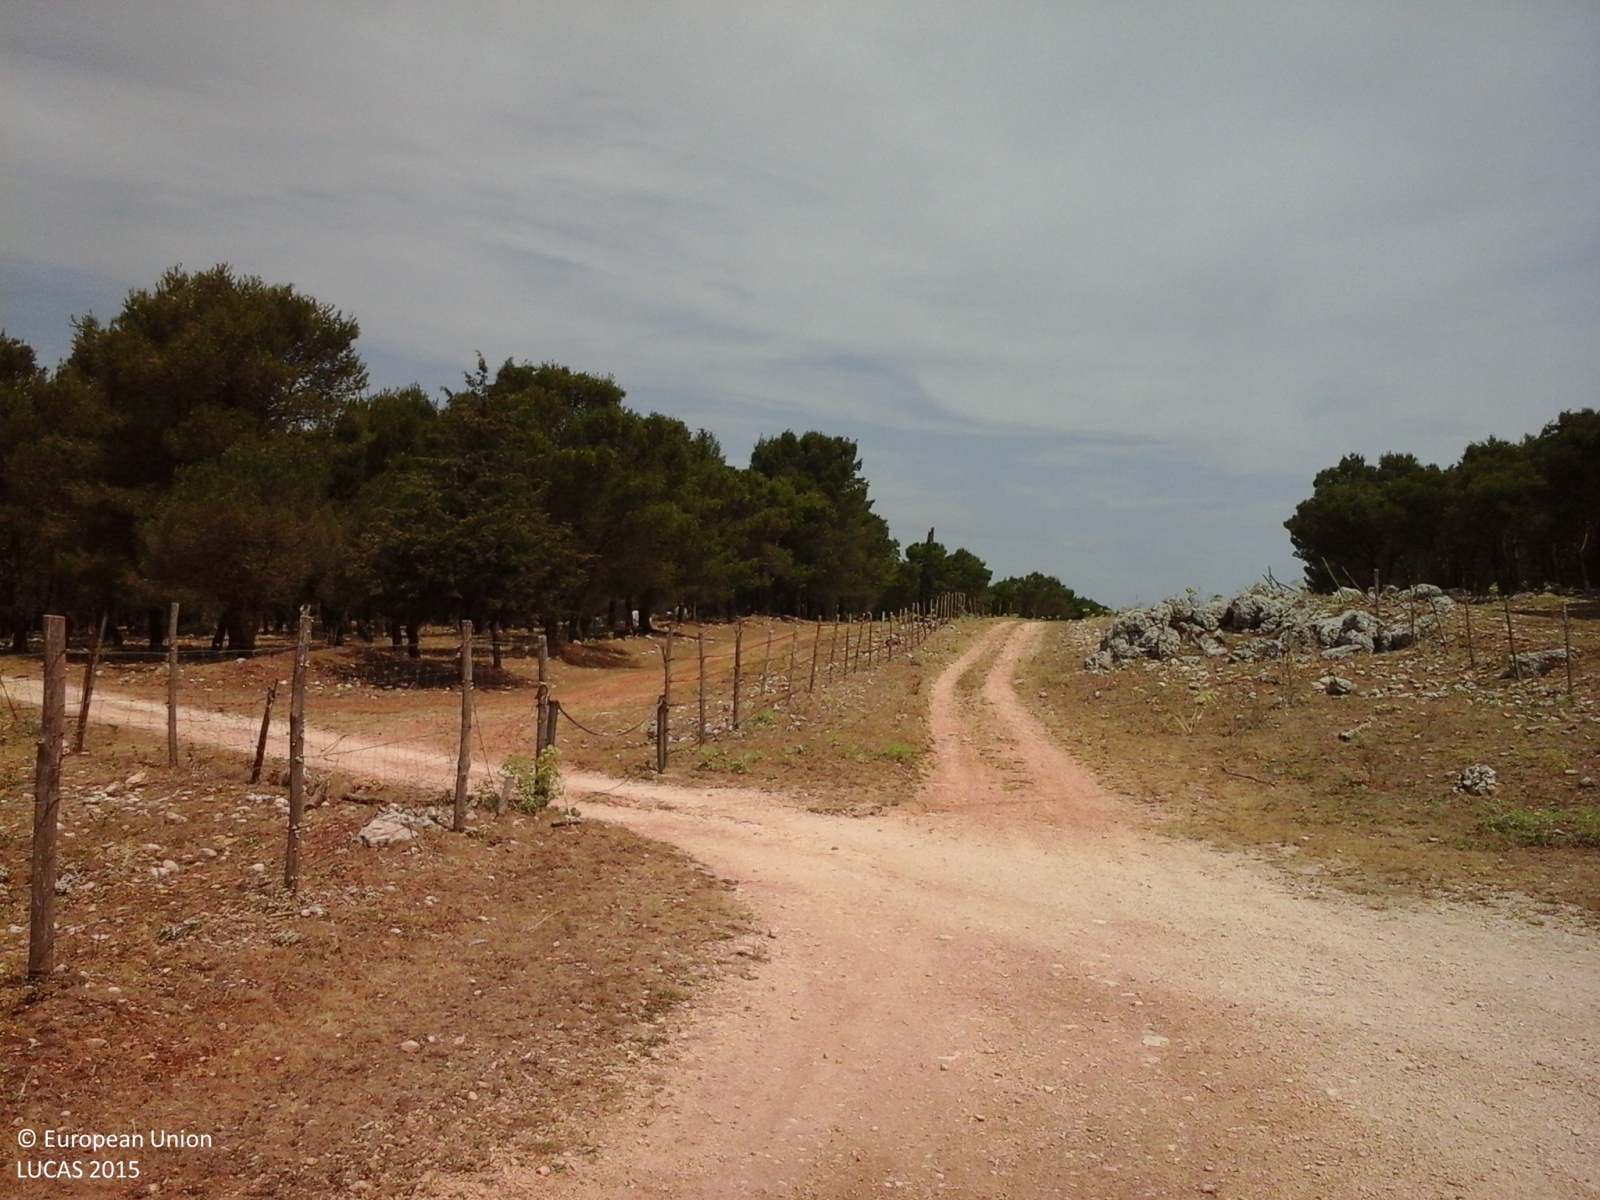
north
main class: Woodland
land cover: Pine dominated coniferous woodland
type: coniferous forest of the mediterranean region
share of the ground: > 75 %
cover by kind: coniferous forest trees 100 %
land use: Forestry
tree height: > 5 m
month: June
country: IT
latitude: 37.6231
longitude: 13.1374
